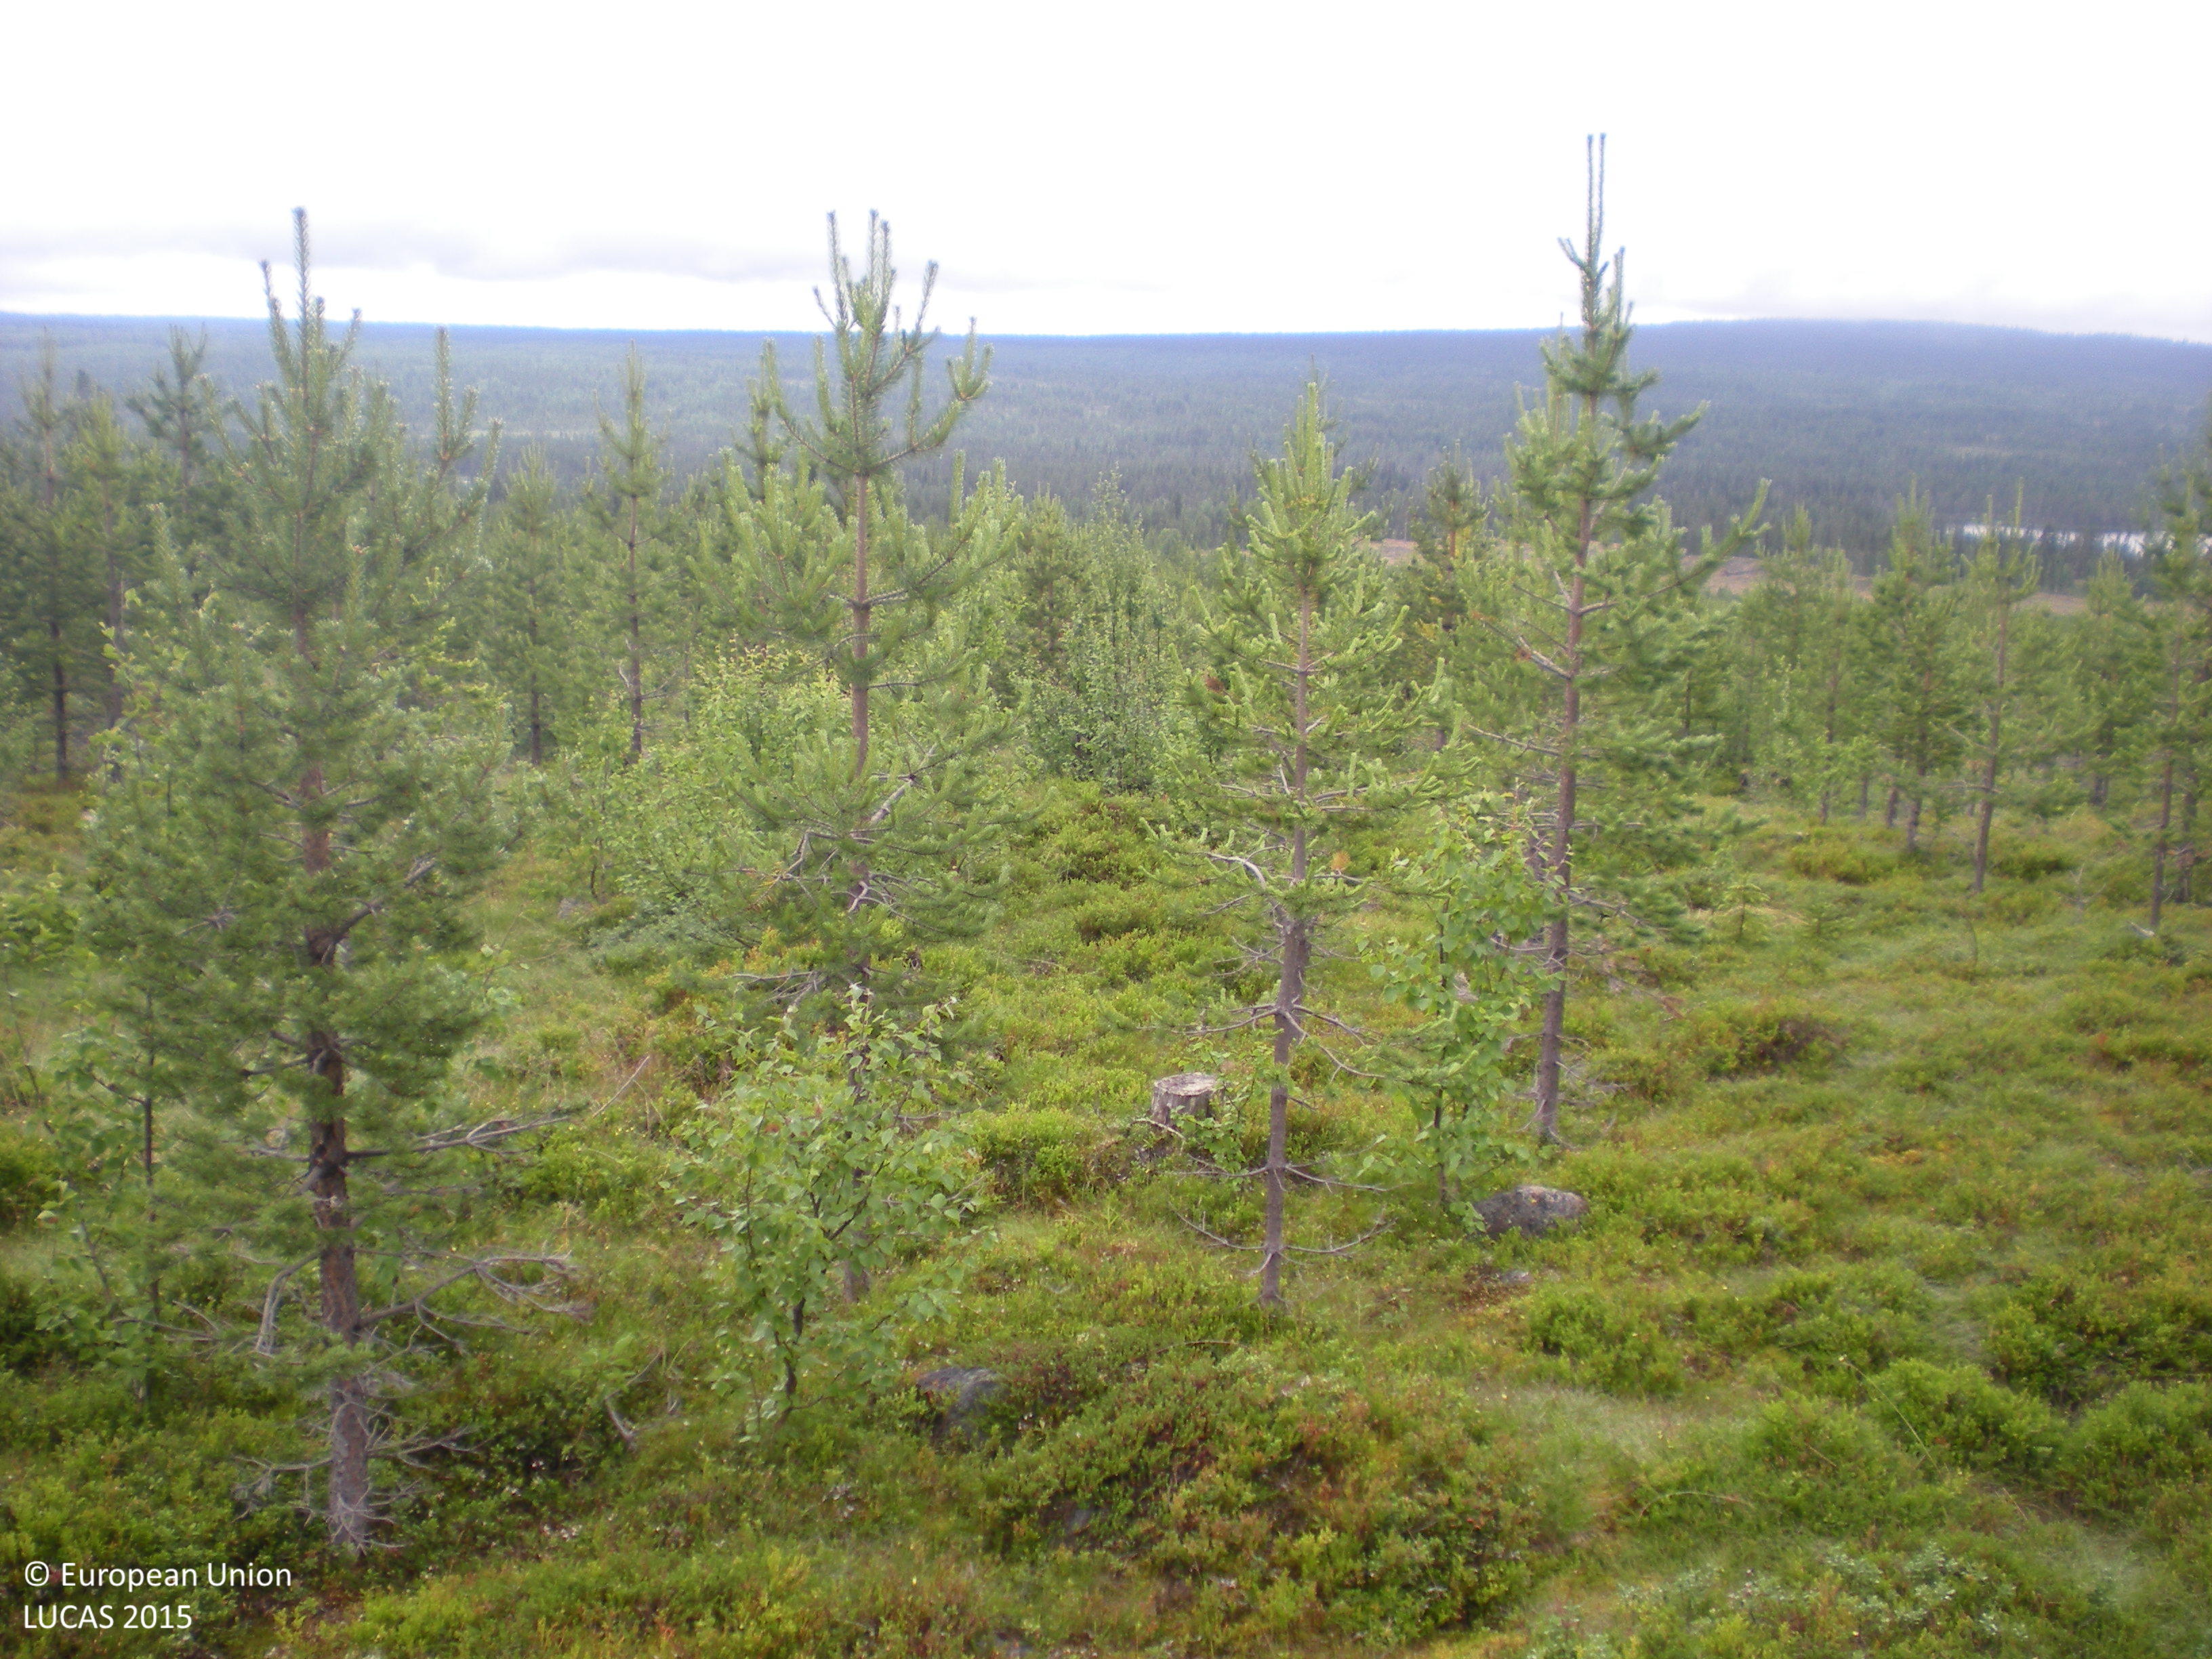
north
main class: Woodland
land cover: Pine dominated mixed woodland
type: boreal forest
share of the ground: 25 - 50 %
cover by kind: coniferous forest trees 35 %, shrubs 30 %, broadleaved forest trees 15 %, lichens and mosses 15 %, herbaceous plants 5 %
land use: Forestry
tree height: < 5 m
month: August
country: SE
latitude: 66.0867
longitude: 18.3781
